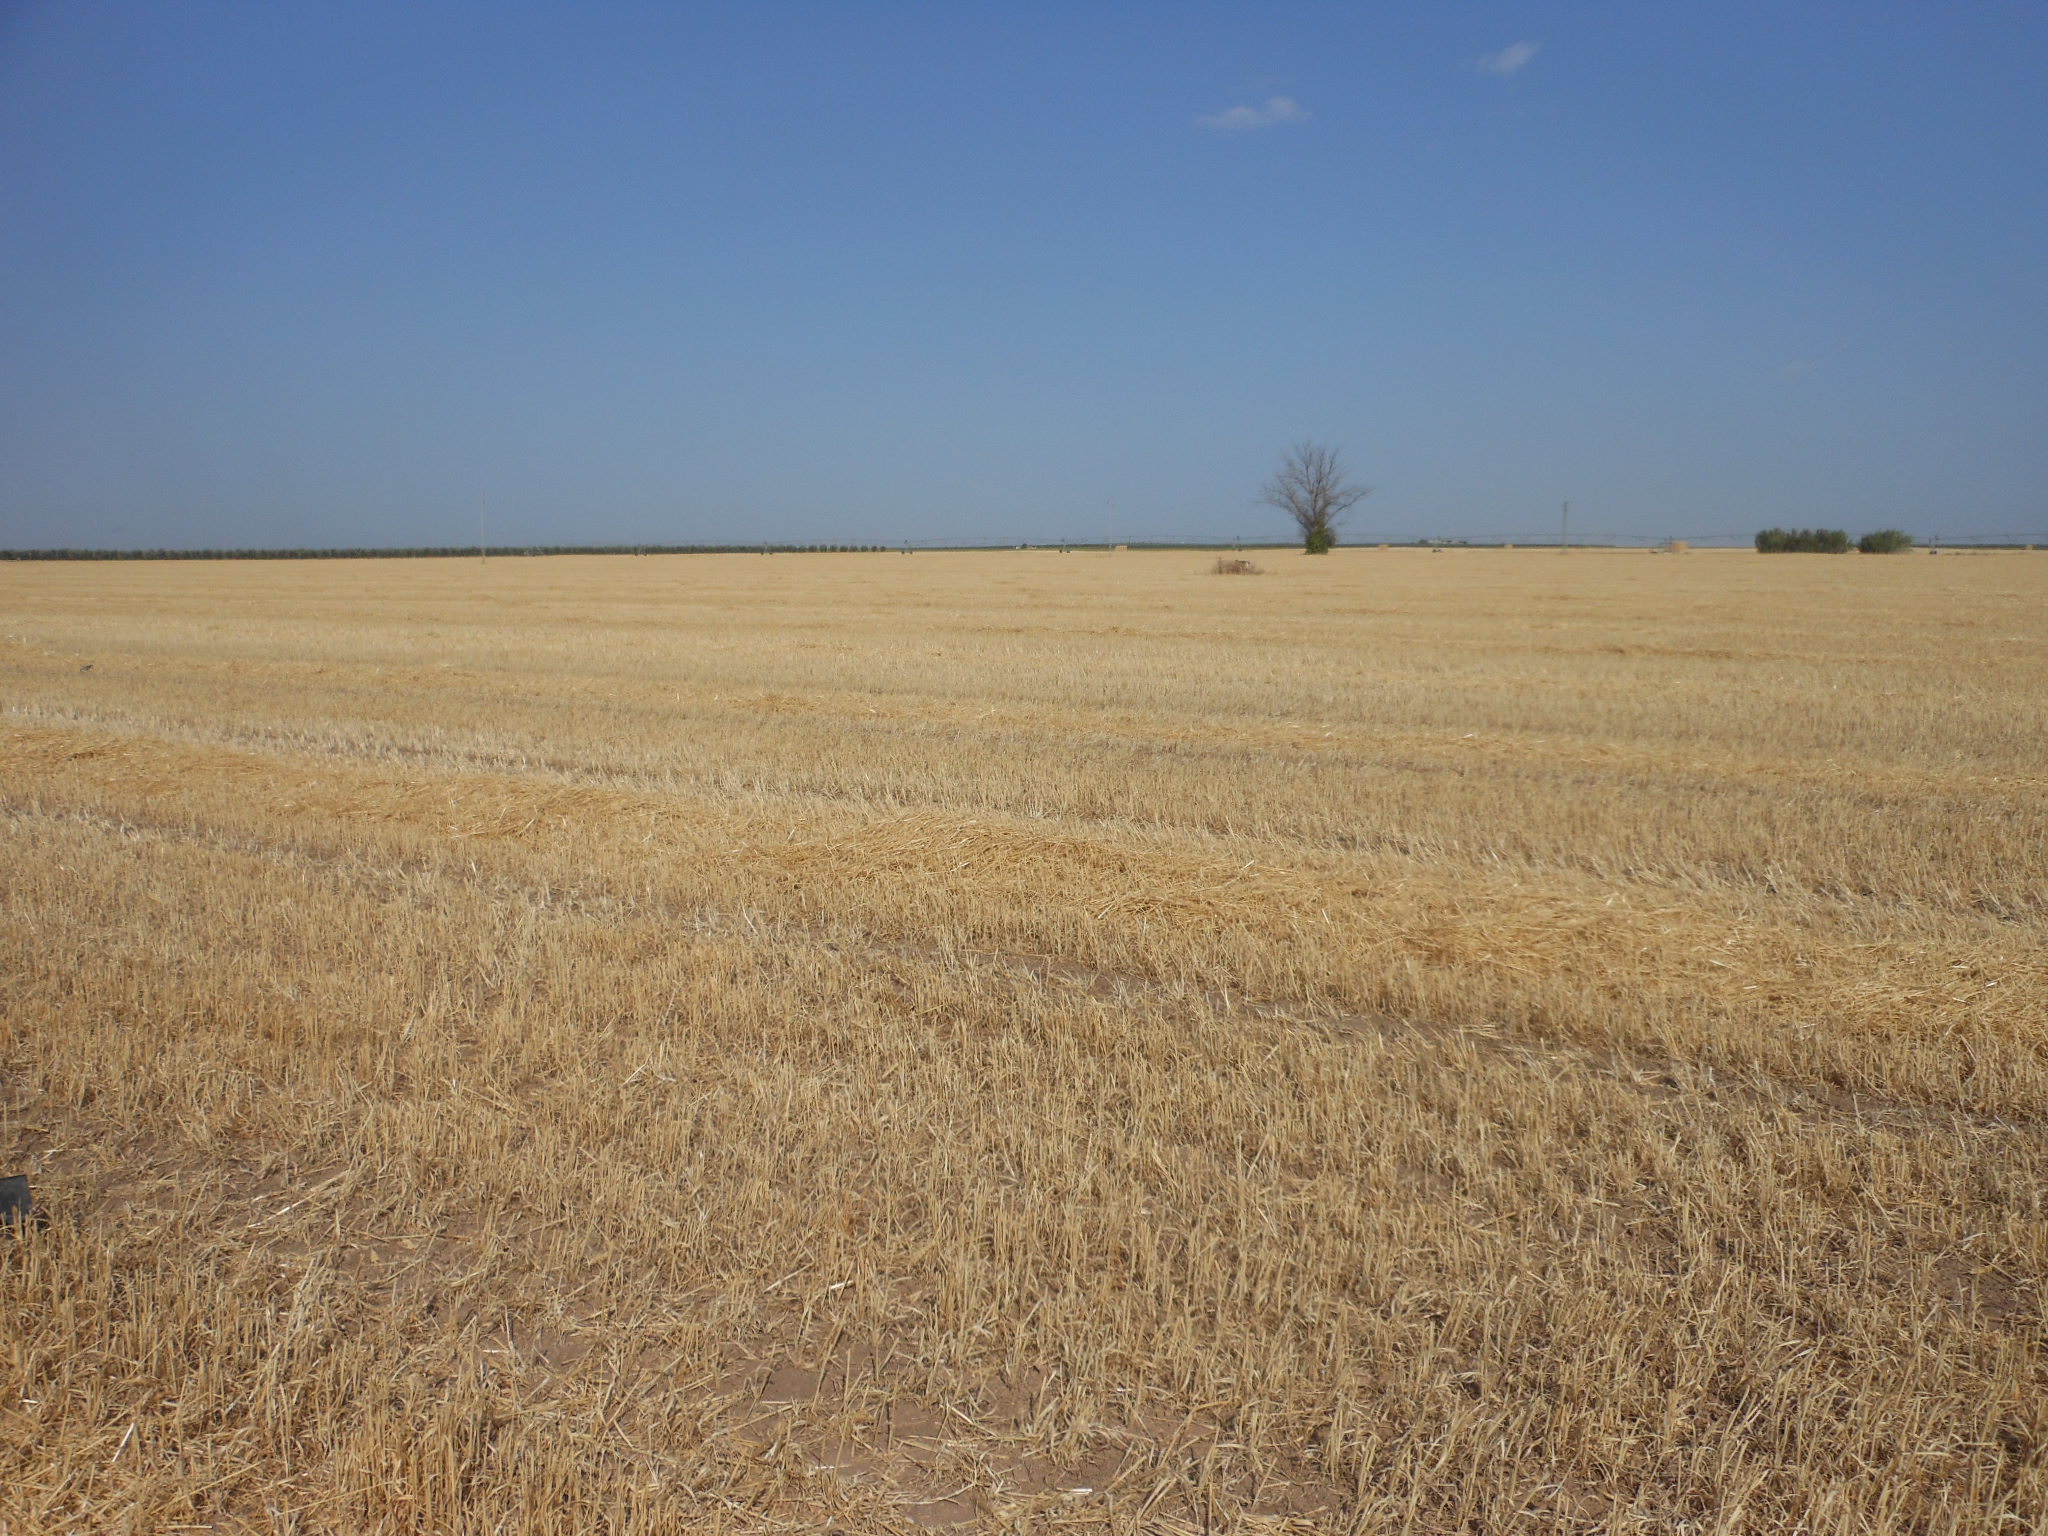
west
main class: Cropland
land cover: Common wheat
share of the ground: < 10 %
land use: Agriculture (excluding fallow land and kitchen gardens)
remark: Harvested field
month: June
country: ES
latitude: 37.3013
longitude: -5.1379
